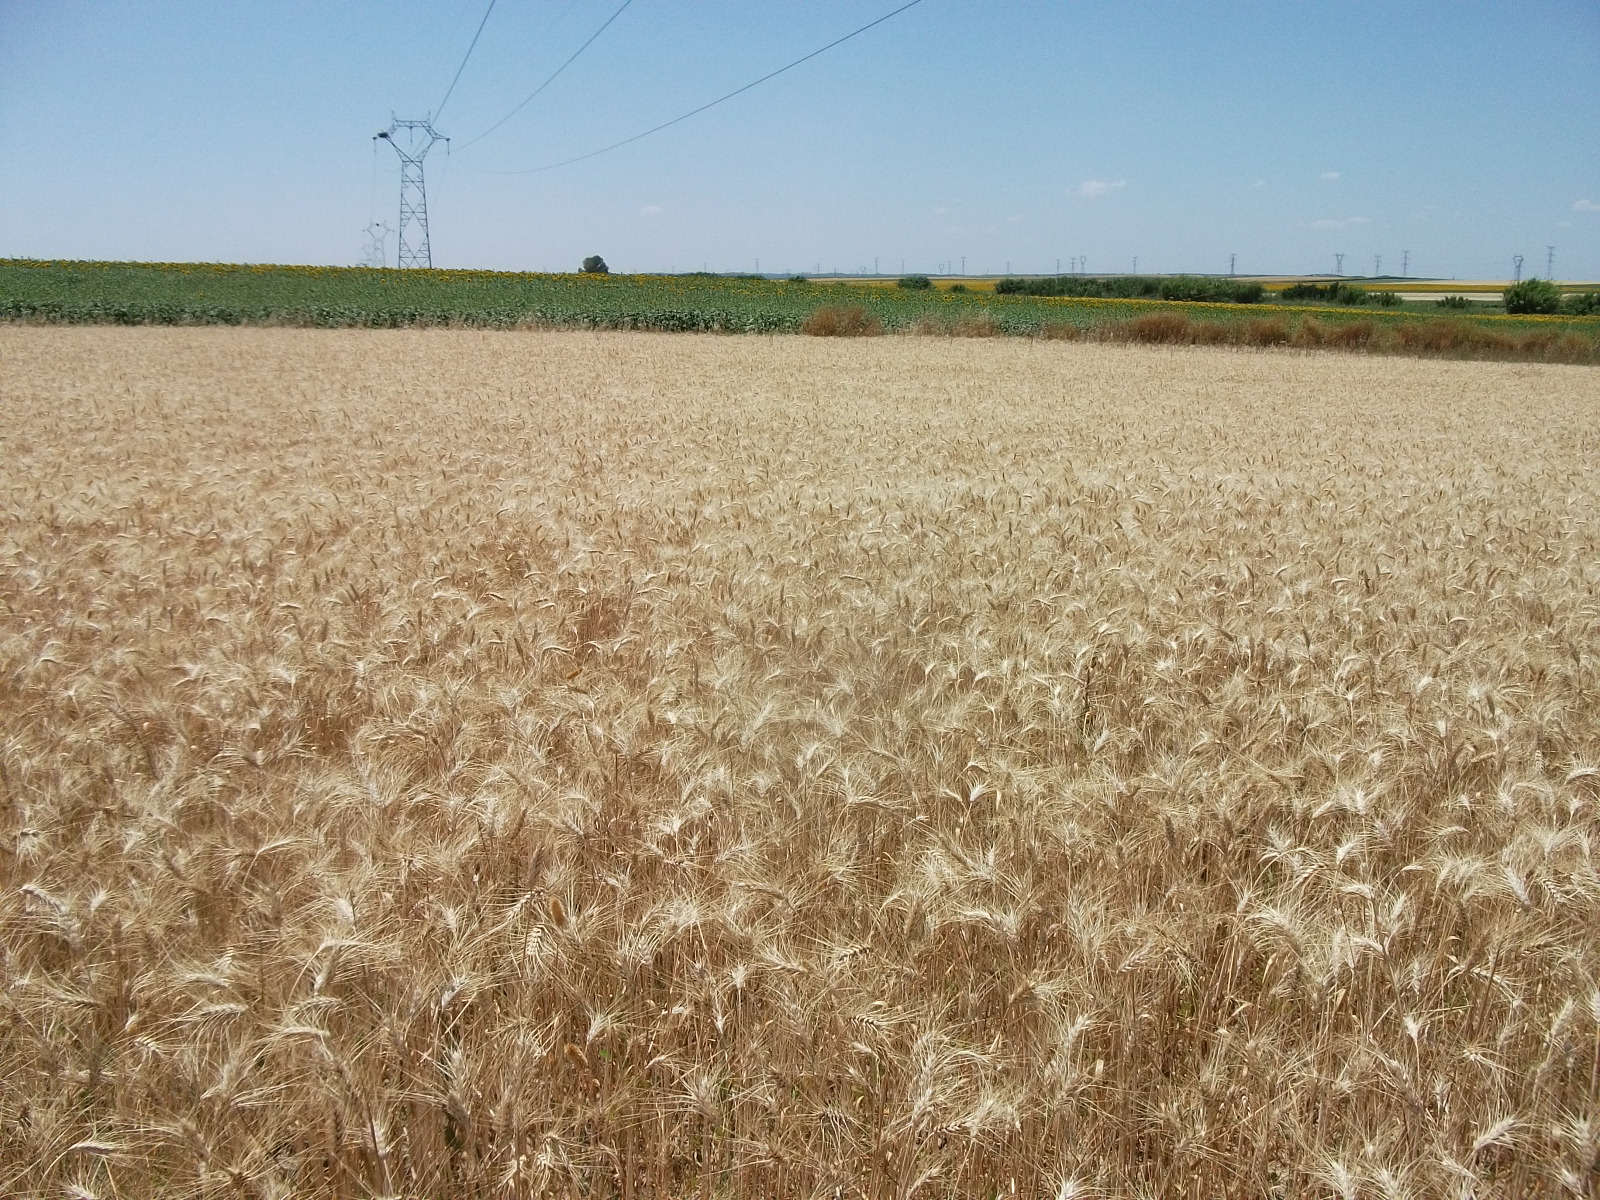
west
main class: Cropland
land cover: Durum wheat
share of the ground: > 75 %
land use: Agriculture (excluding fallow land and kitchen gardens)
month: June
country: ES
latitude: 37.4141
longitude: -6.5409
